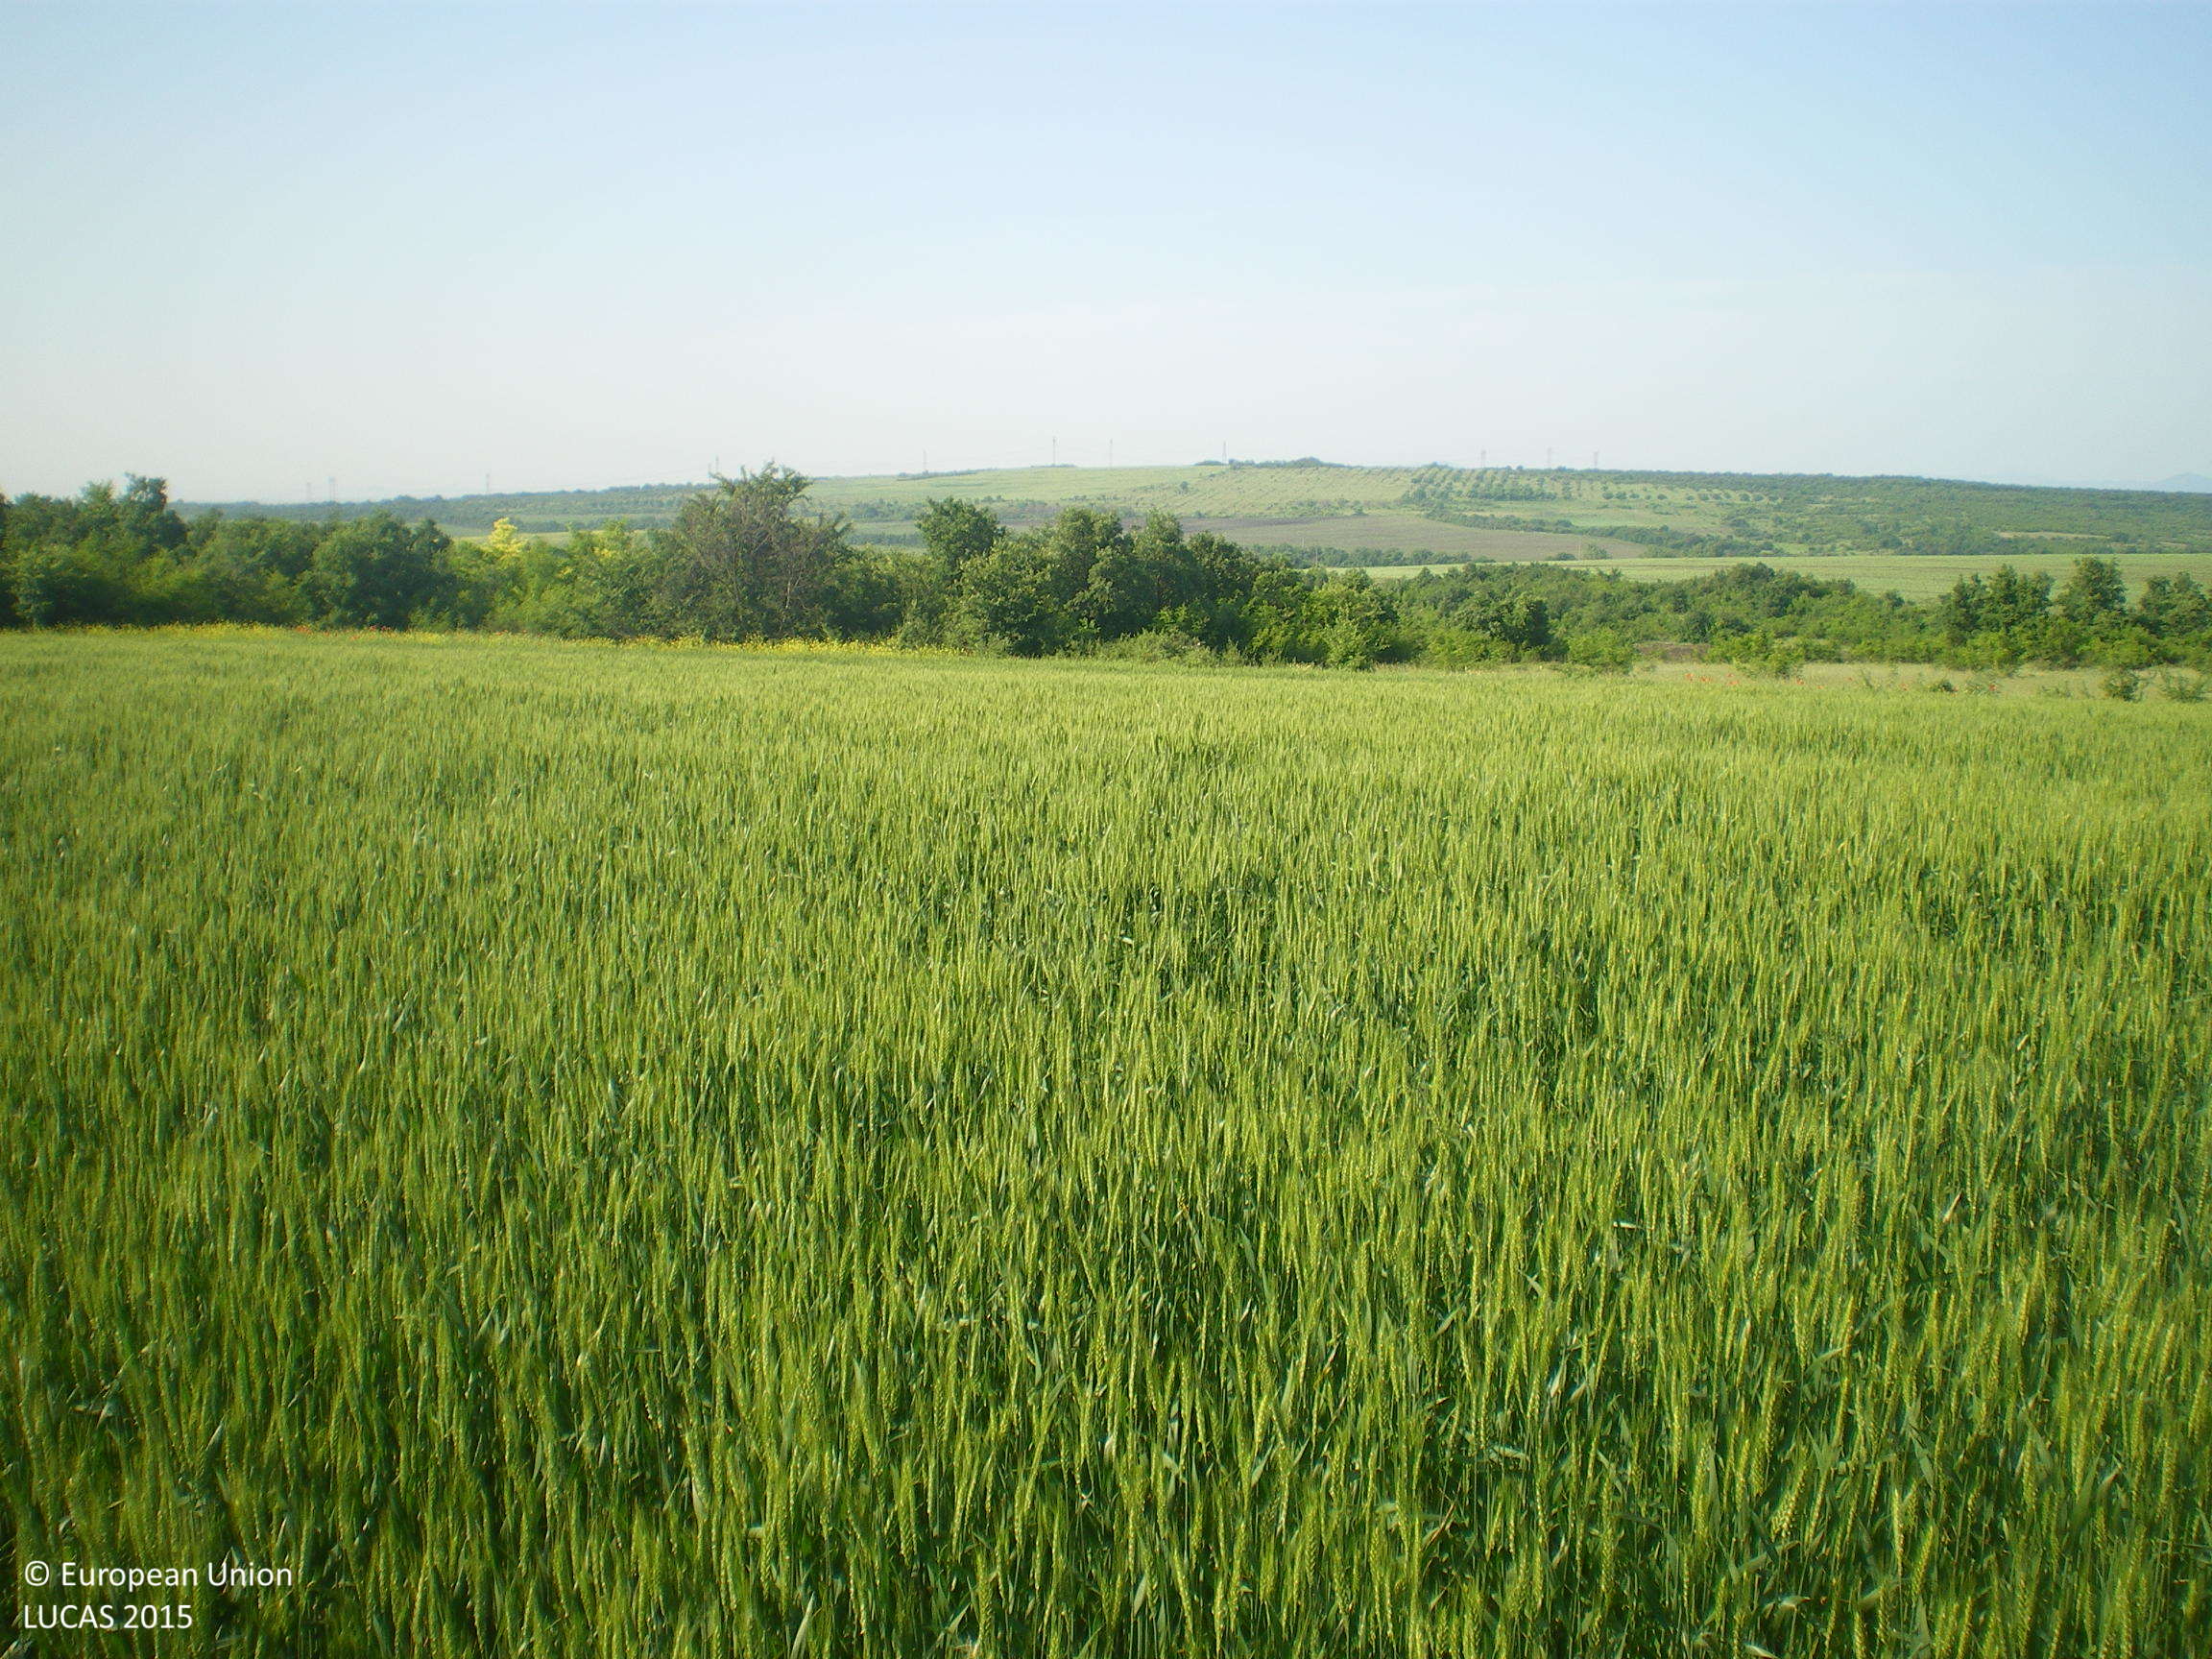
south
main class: Cropland
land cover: Barley
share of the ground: > 75 %
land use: Agriculture (excluding fallow land and kitchen gardens)
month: May
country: BG
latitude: 42.1441
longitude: 25.4192
